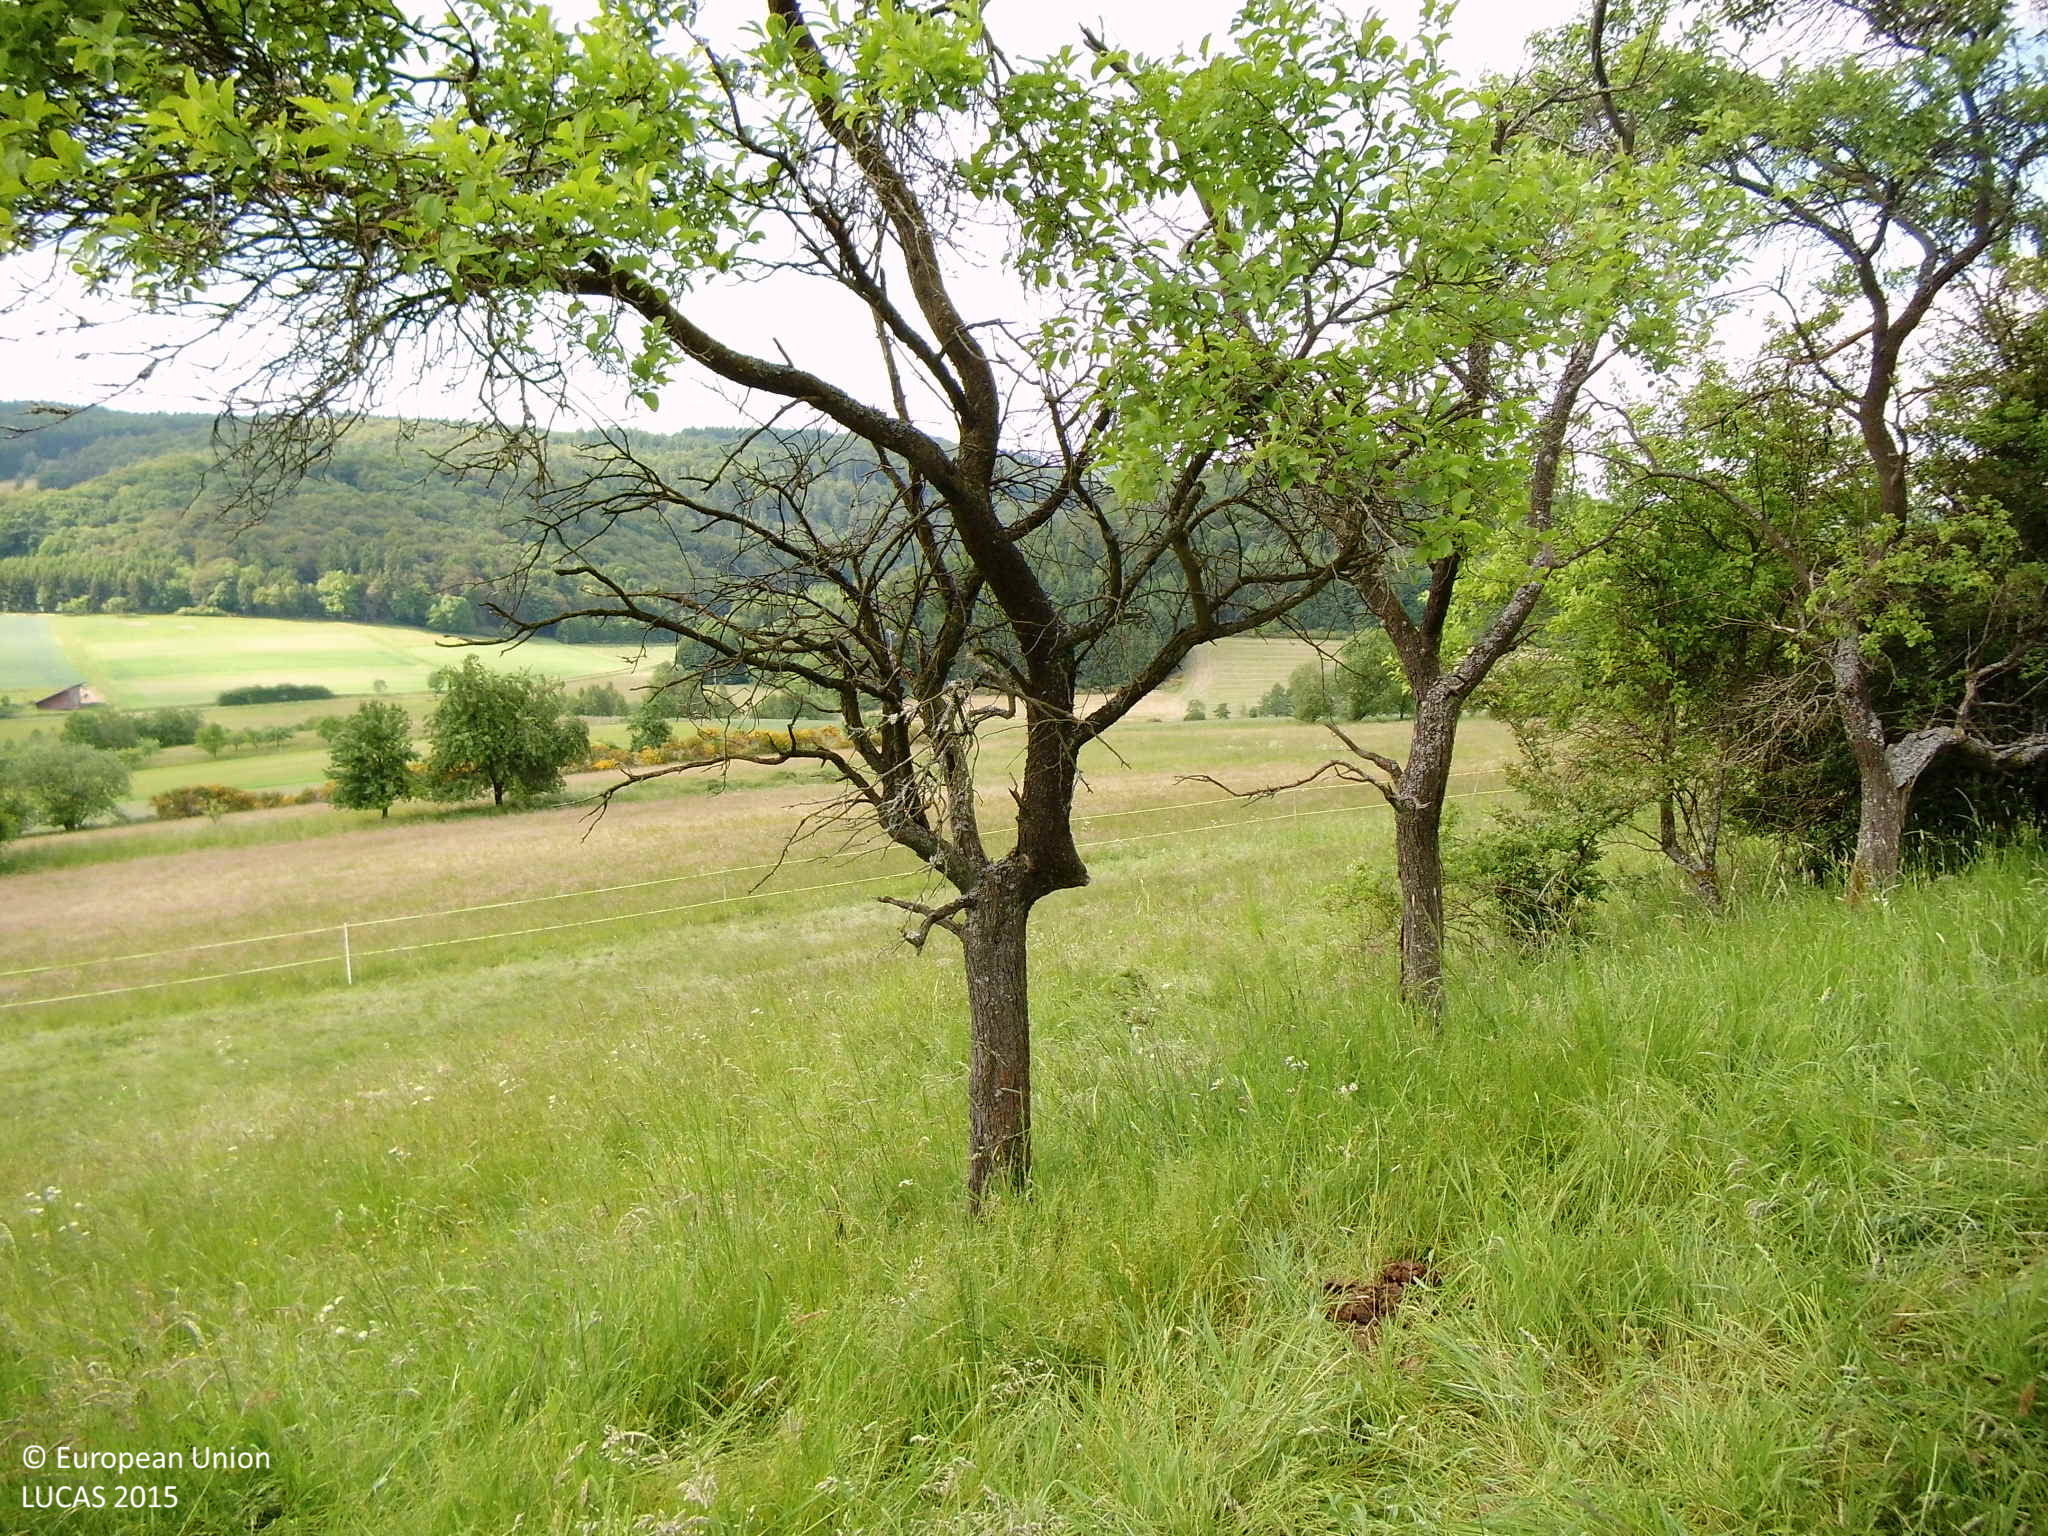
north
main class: Grassland
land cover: Grassland without tree/shrub cover
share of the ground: > 75 %
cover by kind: herbaceous plants 100 %
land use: Agriculture (excluding fallow land and kitchen gardens)
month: June
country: DE
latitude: 50.8391
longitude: 8.4525
